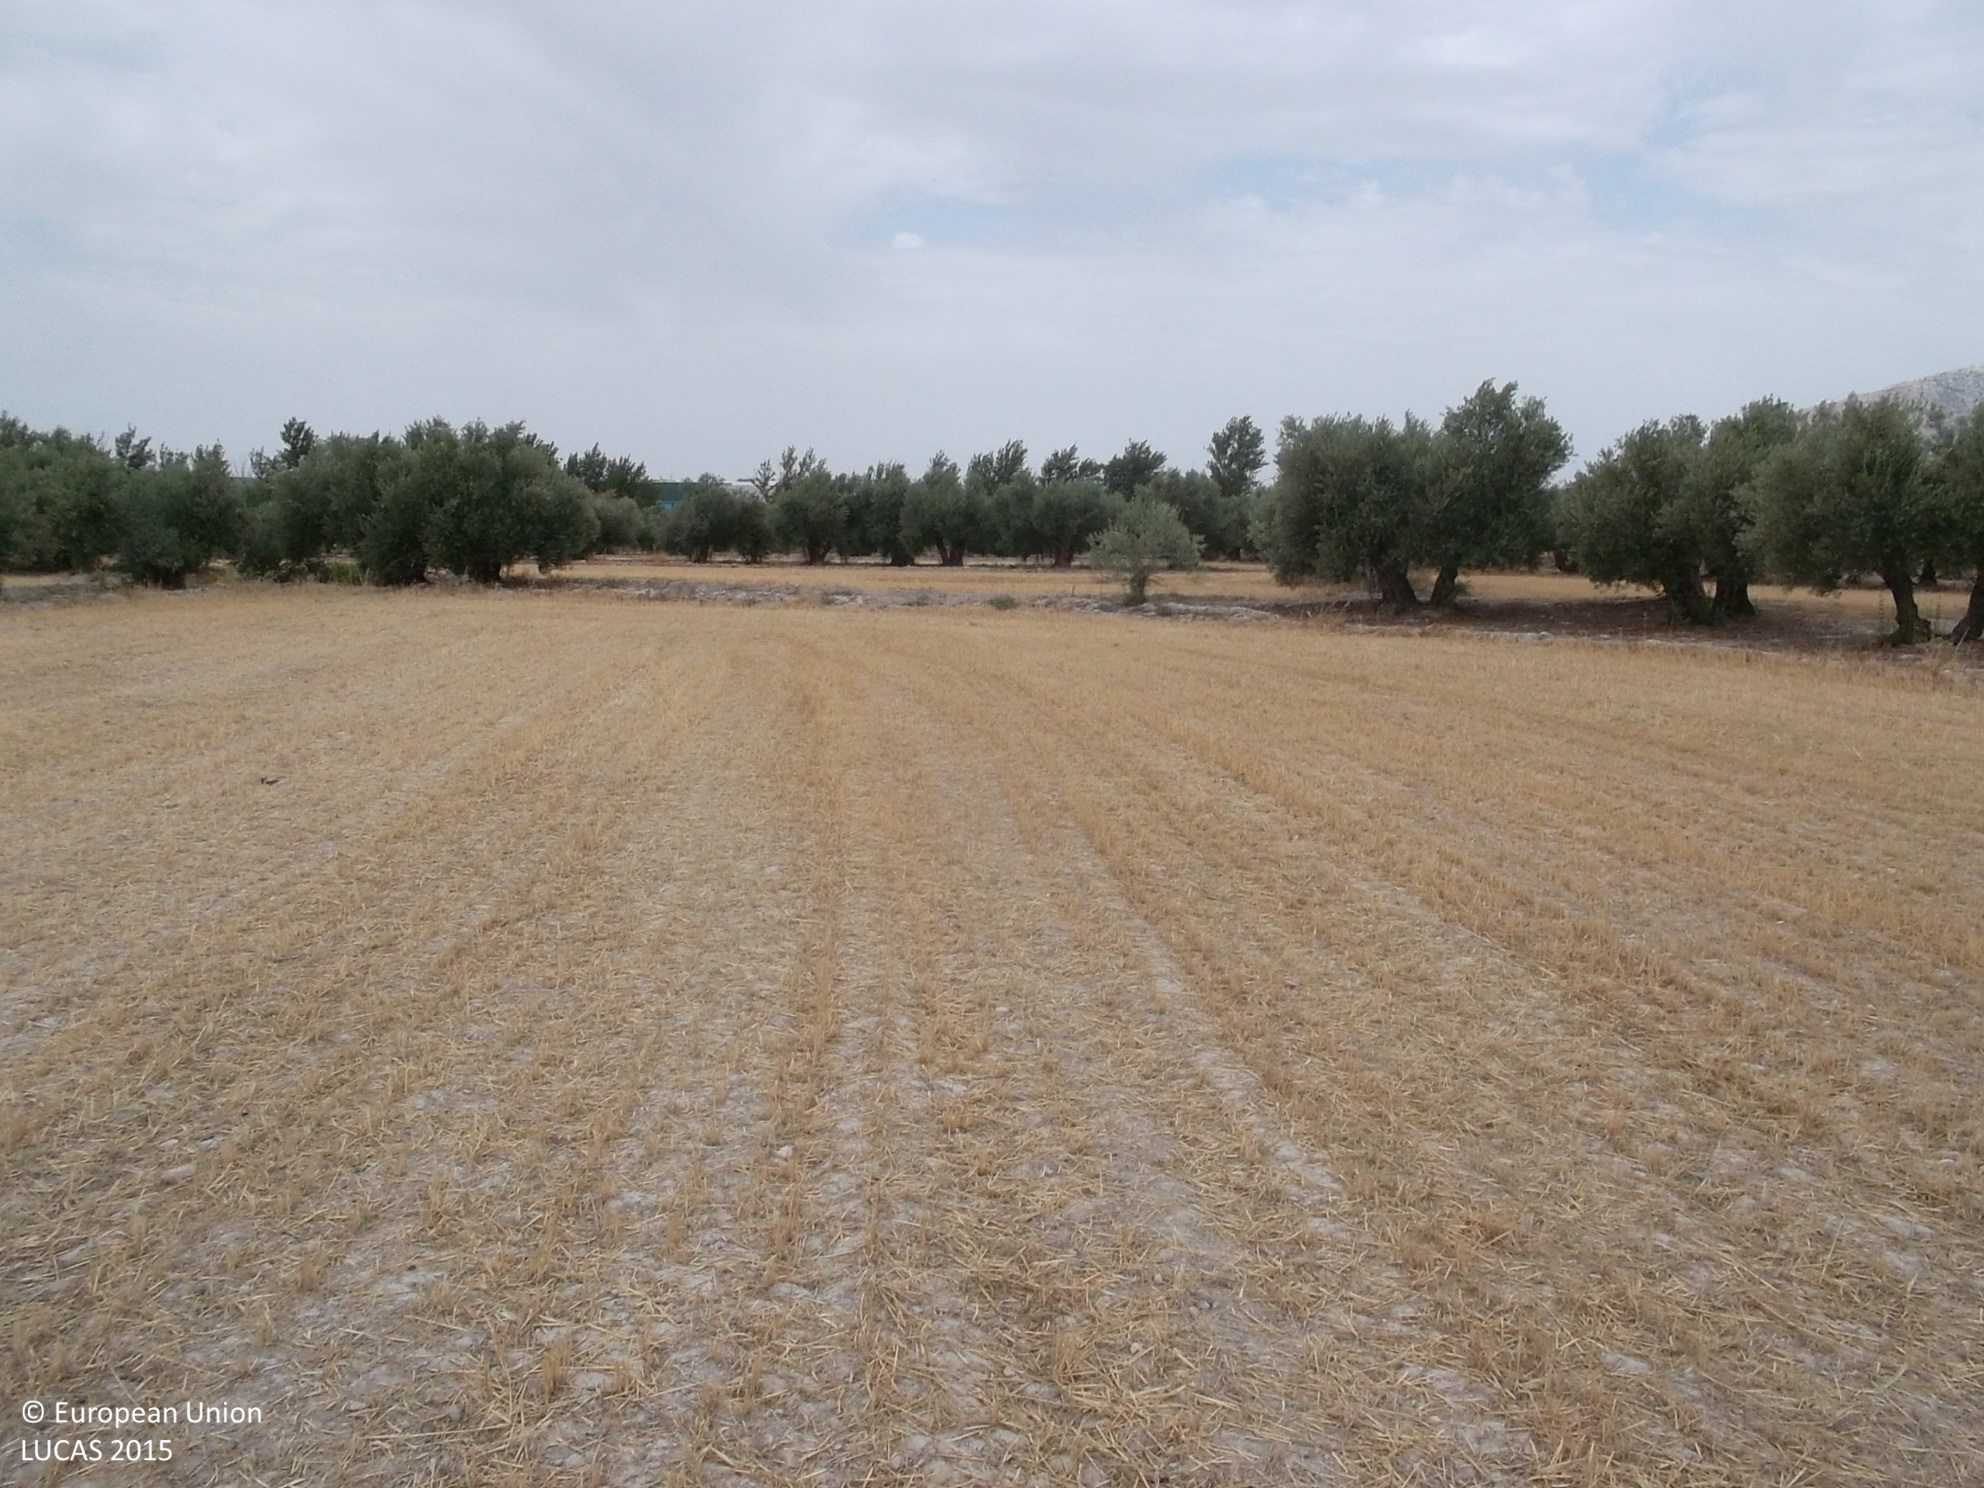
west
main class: Cropland
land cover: Common wheat
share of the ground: < 10 %
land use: Agriculture (excluding fallow land and kitchen gardens)
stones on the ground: < 10 %
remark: Harvested field
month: July
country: ES
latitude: 37.5286
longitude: -2.7403
